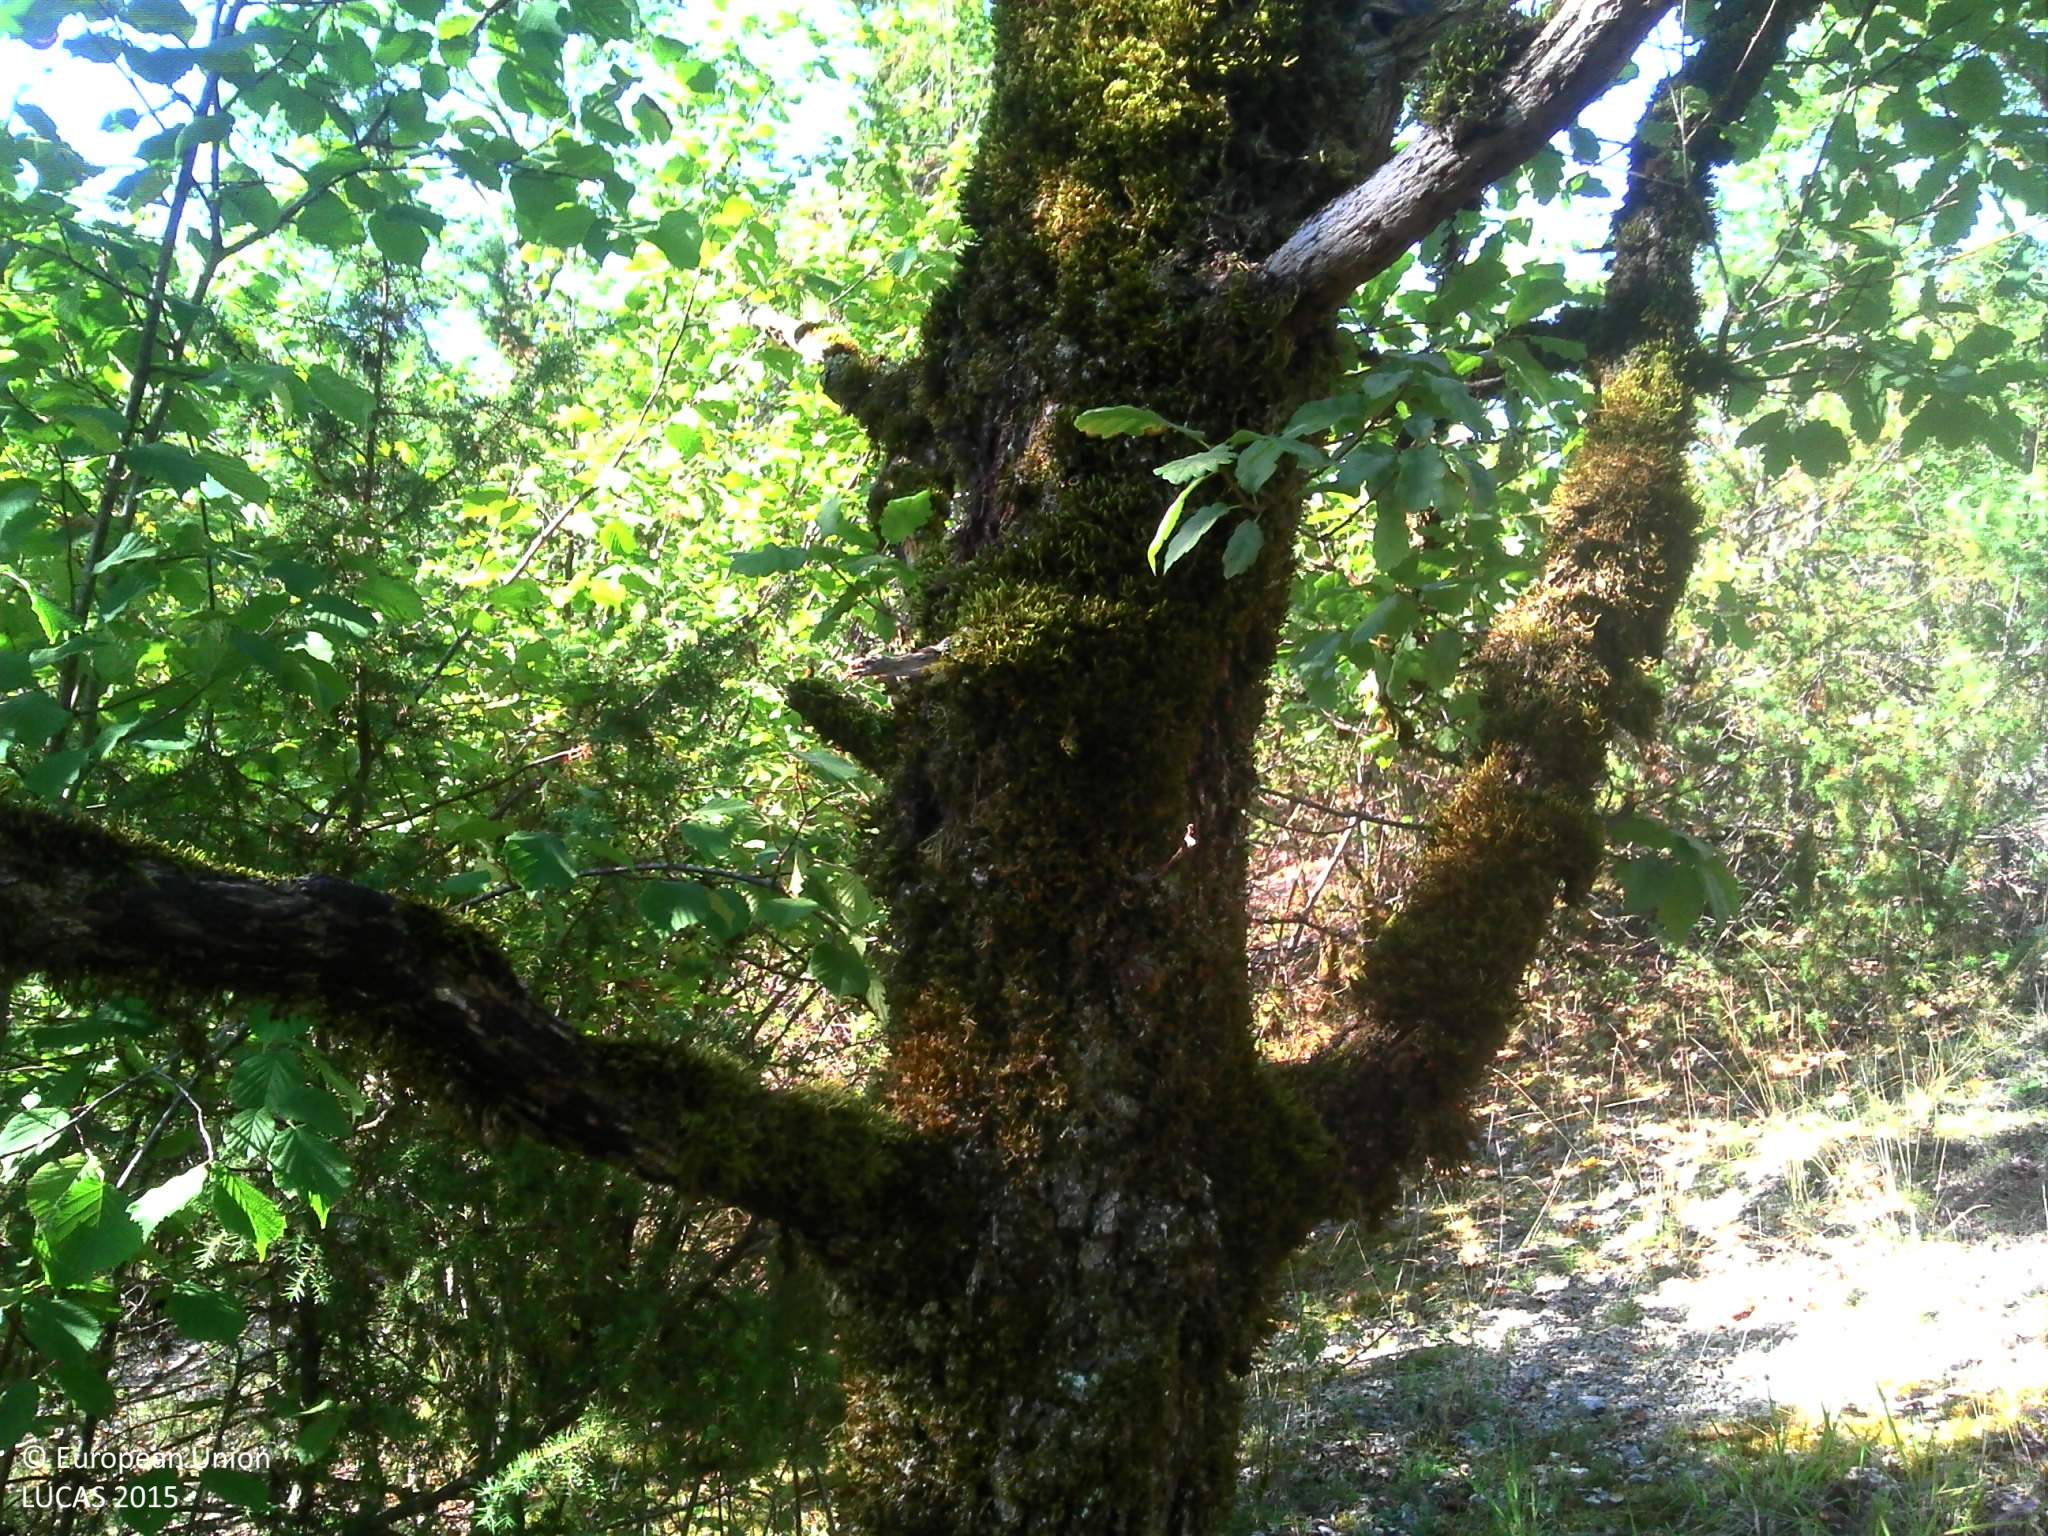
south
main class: Shrubland
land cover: Shrubland with sparse tree cover
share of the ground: > 75 %
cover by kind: shrubs 45 %, unconsolidated bare surface 30 %, herbaceous plants 20 %, broadleaved forest trees 5 %
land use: Forestry
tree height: > 5 m
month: August
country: FR
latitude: 44.7723
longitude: 1.6199
